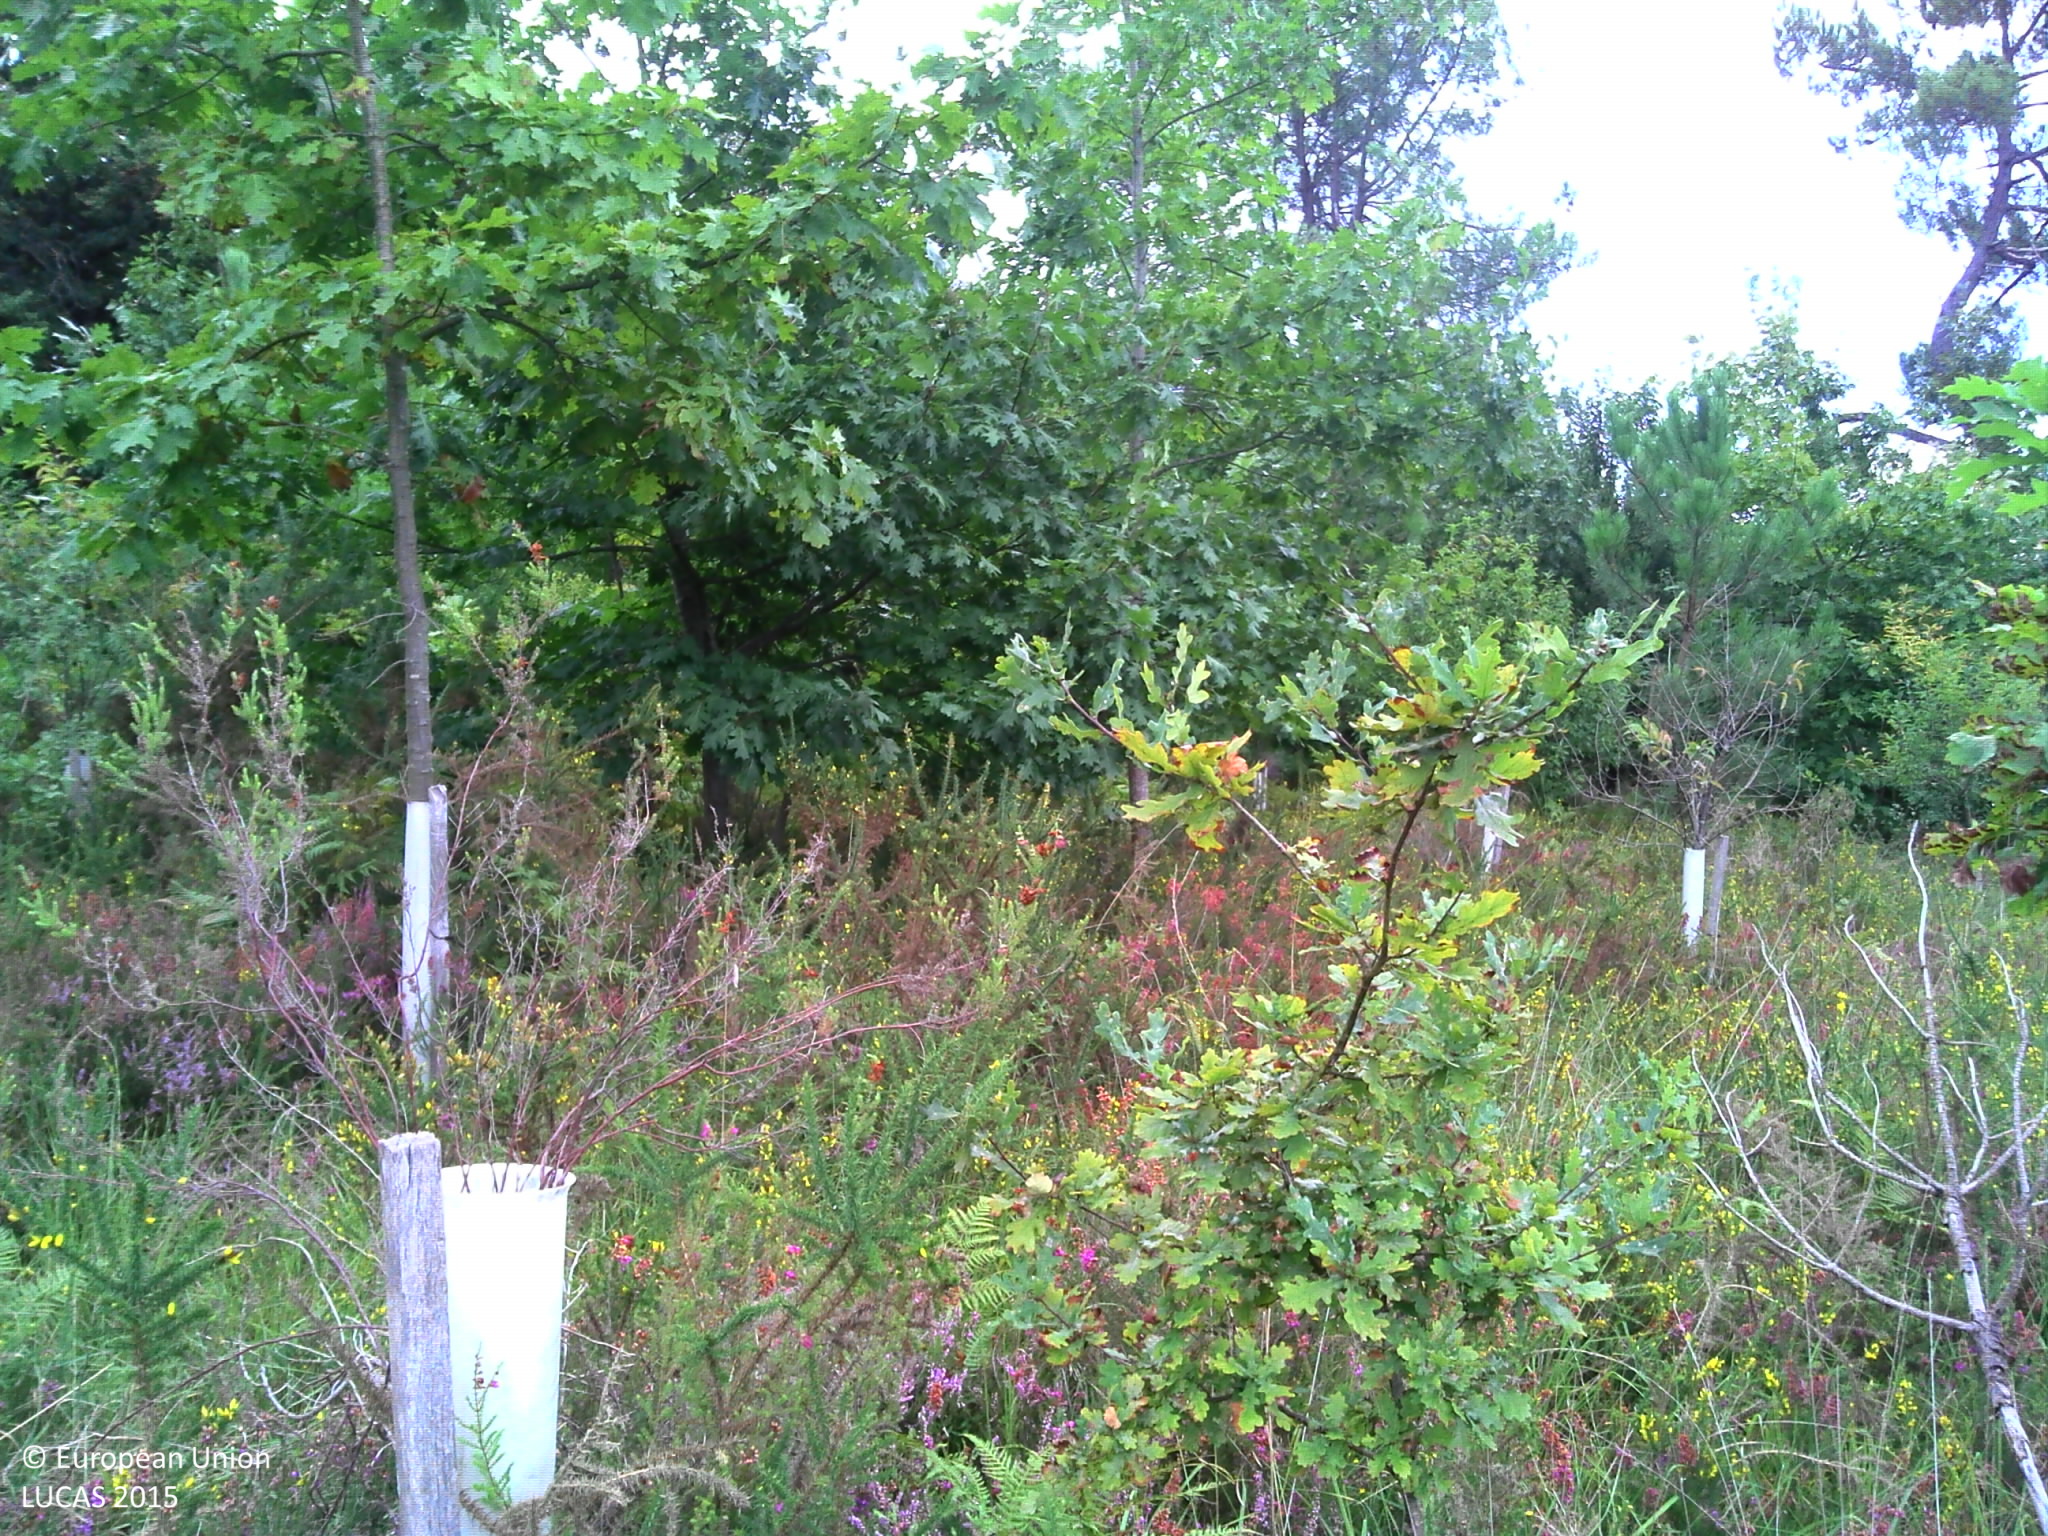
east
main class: Woodland
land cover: Broadleaved woodland
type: exotic forest
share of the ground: 10 - 25 %
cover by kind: shrubs 40 %, herbaceous plants 40 %, broadleaved forest trees 20 %
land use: Forestry
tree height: > 5 m
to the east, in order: Broadleaved woodland; Pine dominated mixed woodland; Shrubland with sparse tree cover
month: September
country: FR
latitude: 43.3585
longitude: -0.7076
